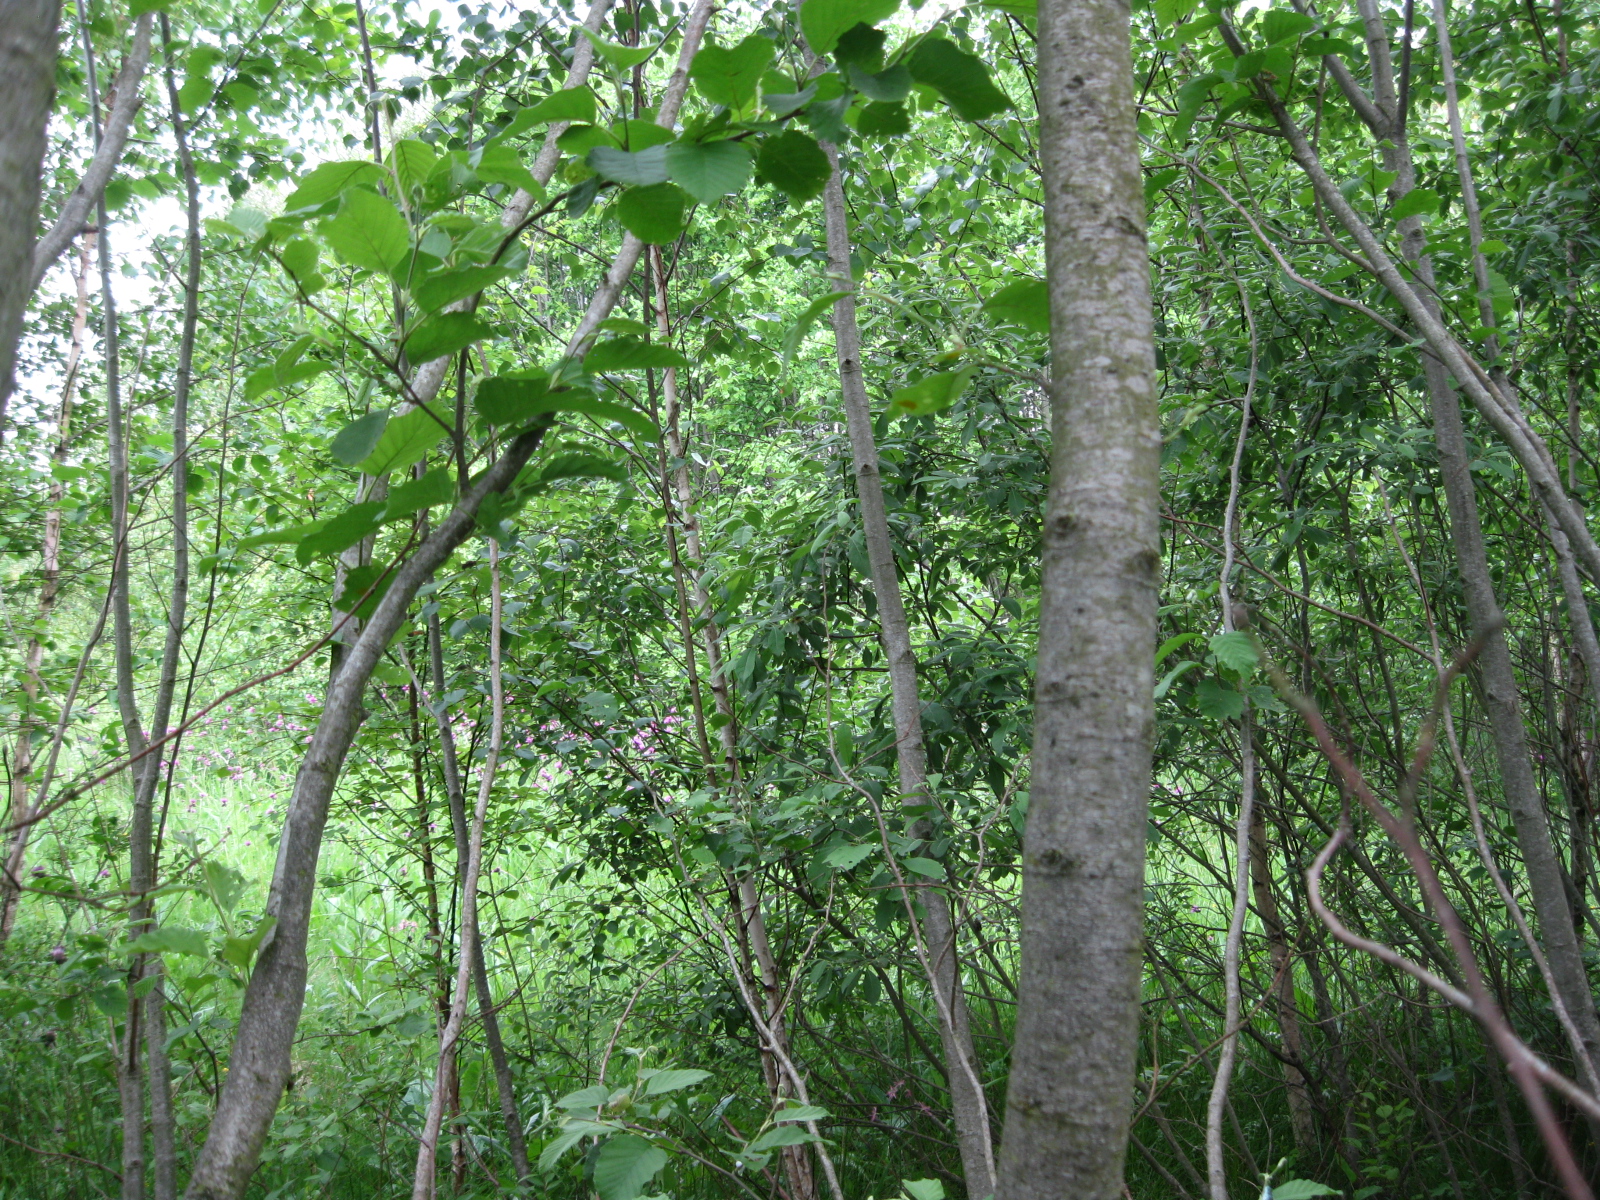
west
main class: Woodland
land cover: Broadleaved woodland
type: floodplain forest
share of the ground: 50 - 75 %
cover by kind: broadleaved forest trees 65 %, herbaceous plants 25 %, shrubs 10 %
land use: Semi-natural and natural areas not in use
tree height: > 5 m
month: June
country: LT
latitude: 55.3214
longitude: 23.5228
